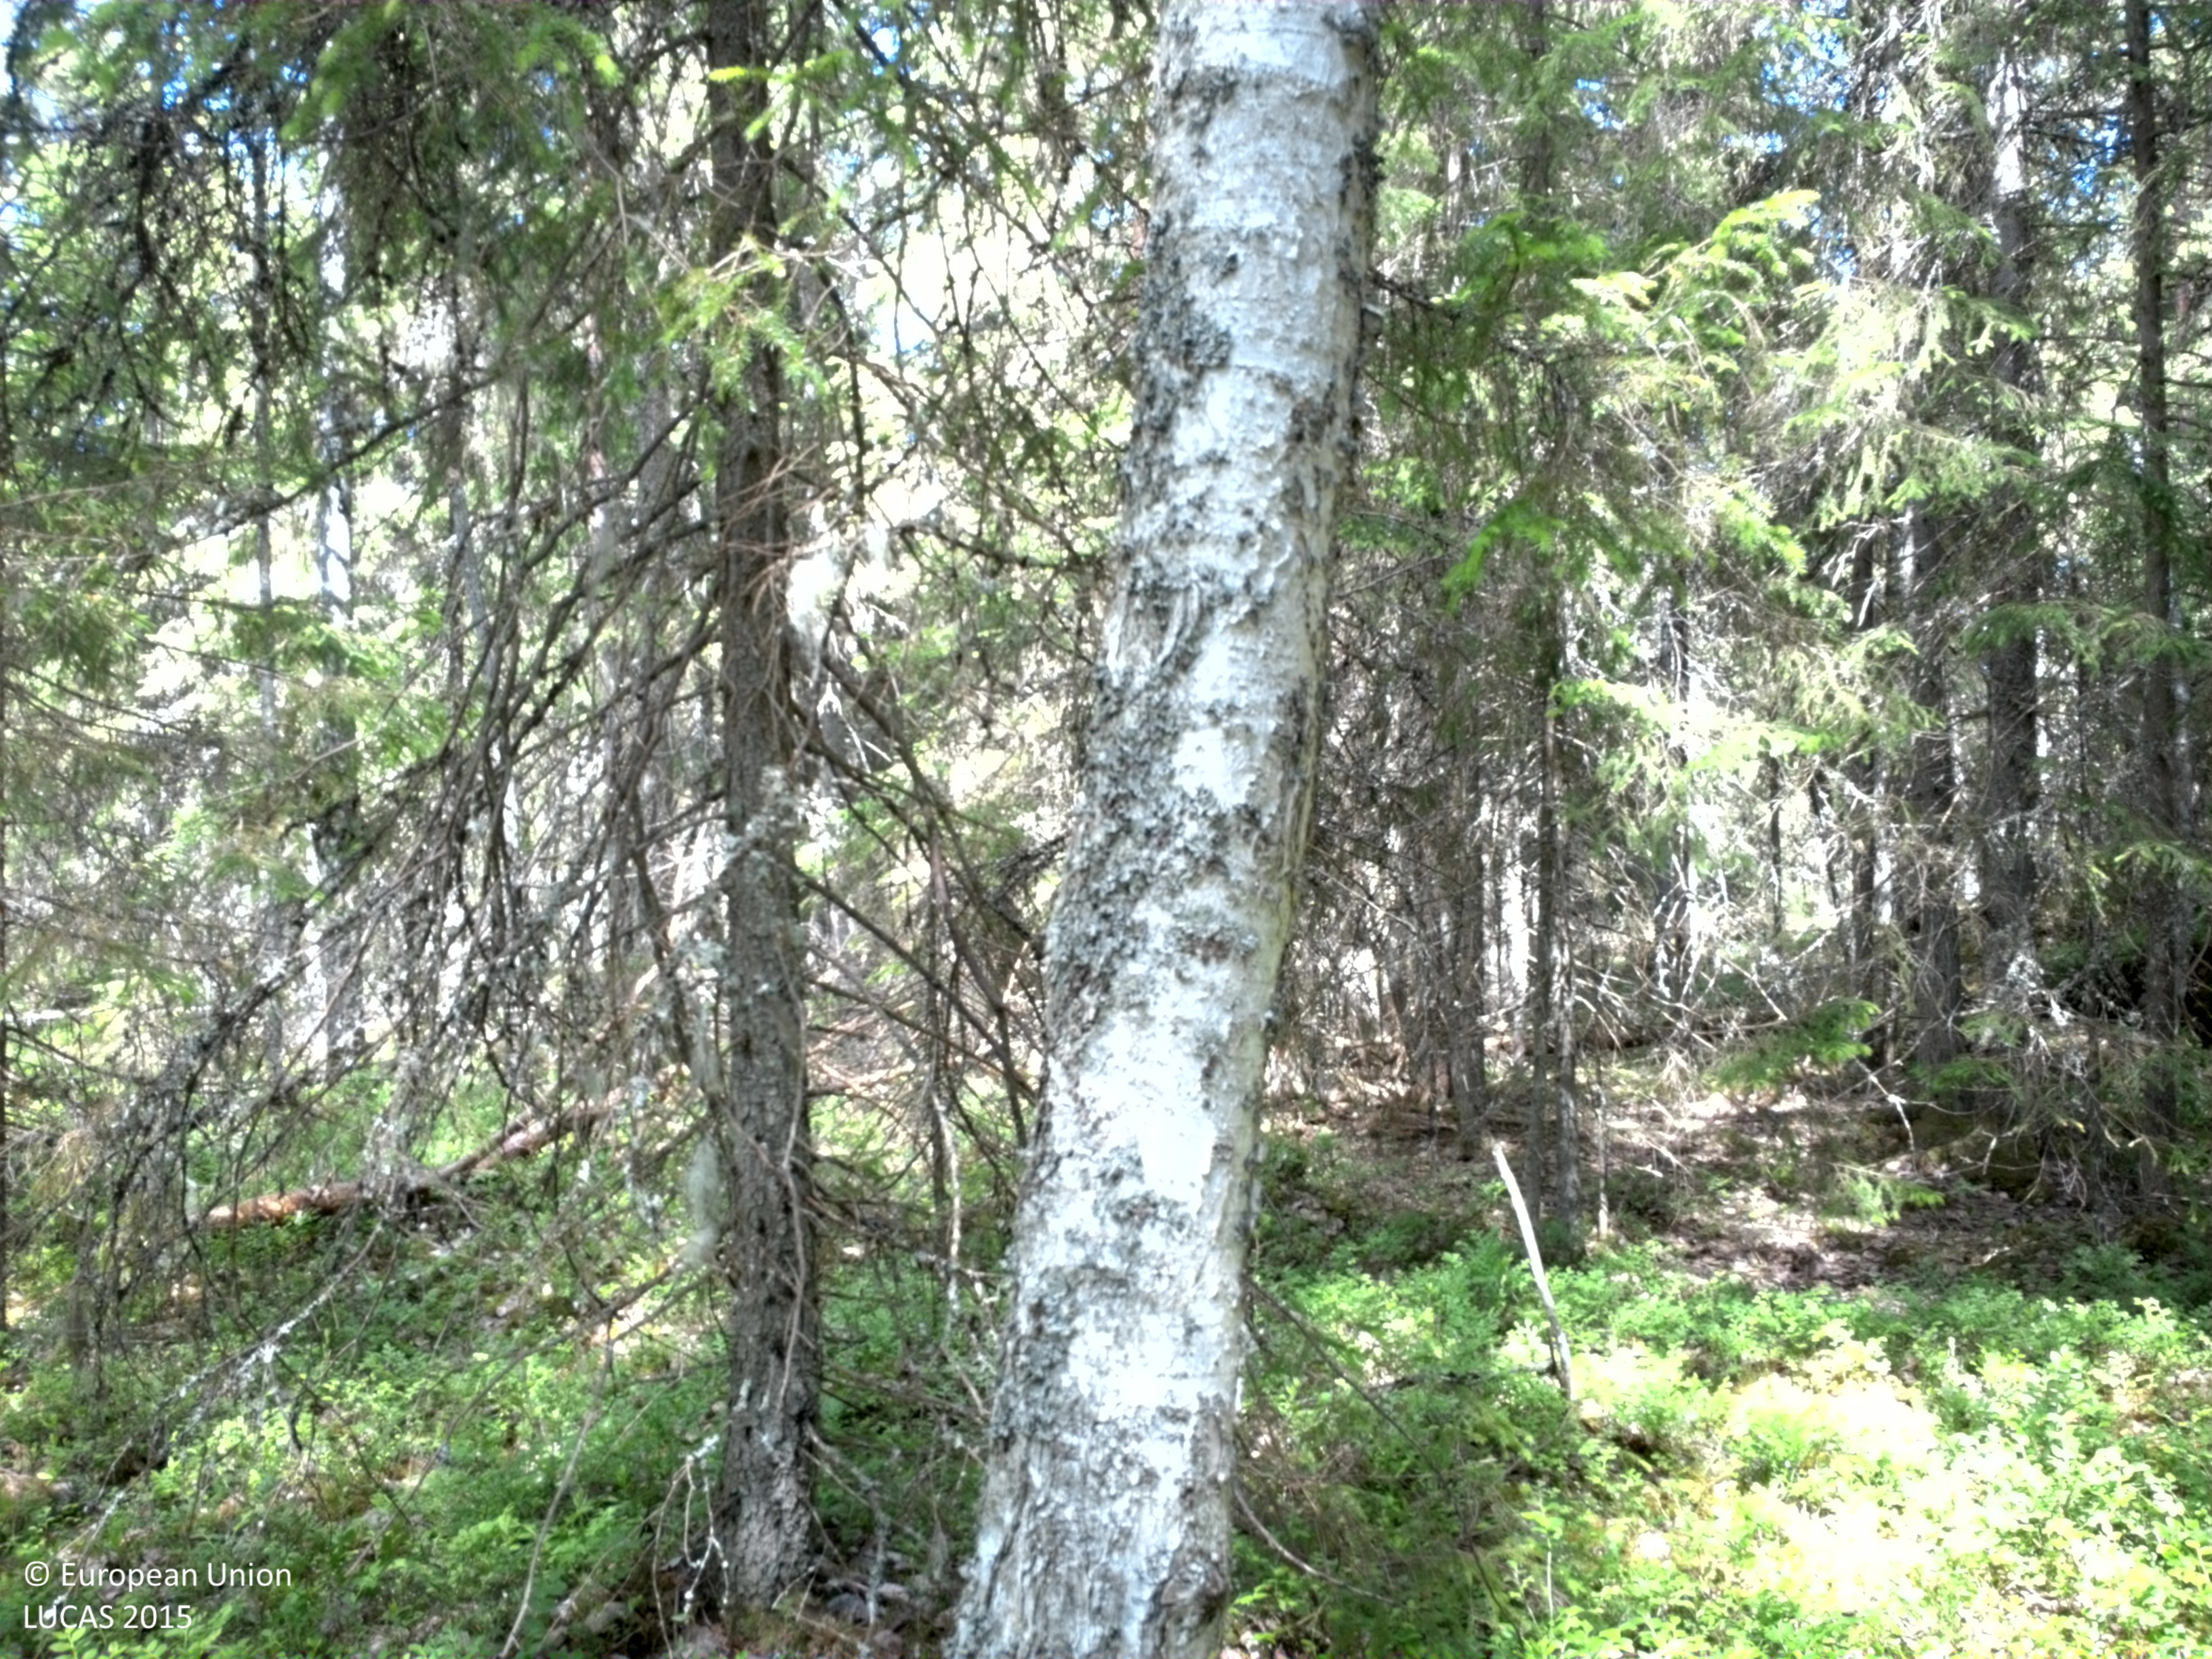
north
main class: Woodland
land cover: Spruce dominated coniferous woodland
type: boreal forest
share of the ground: > 75 %
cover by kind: coniferous forest trees 70 %, broadleaved forest trees 10 %, herbaceous plants 10 %, lichens and mosses 10 %
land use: Forestry
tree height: > 5 m
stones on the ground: < 10 %
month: June
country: SE
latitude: 60.0783
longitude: 18.6428
